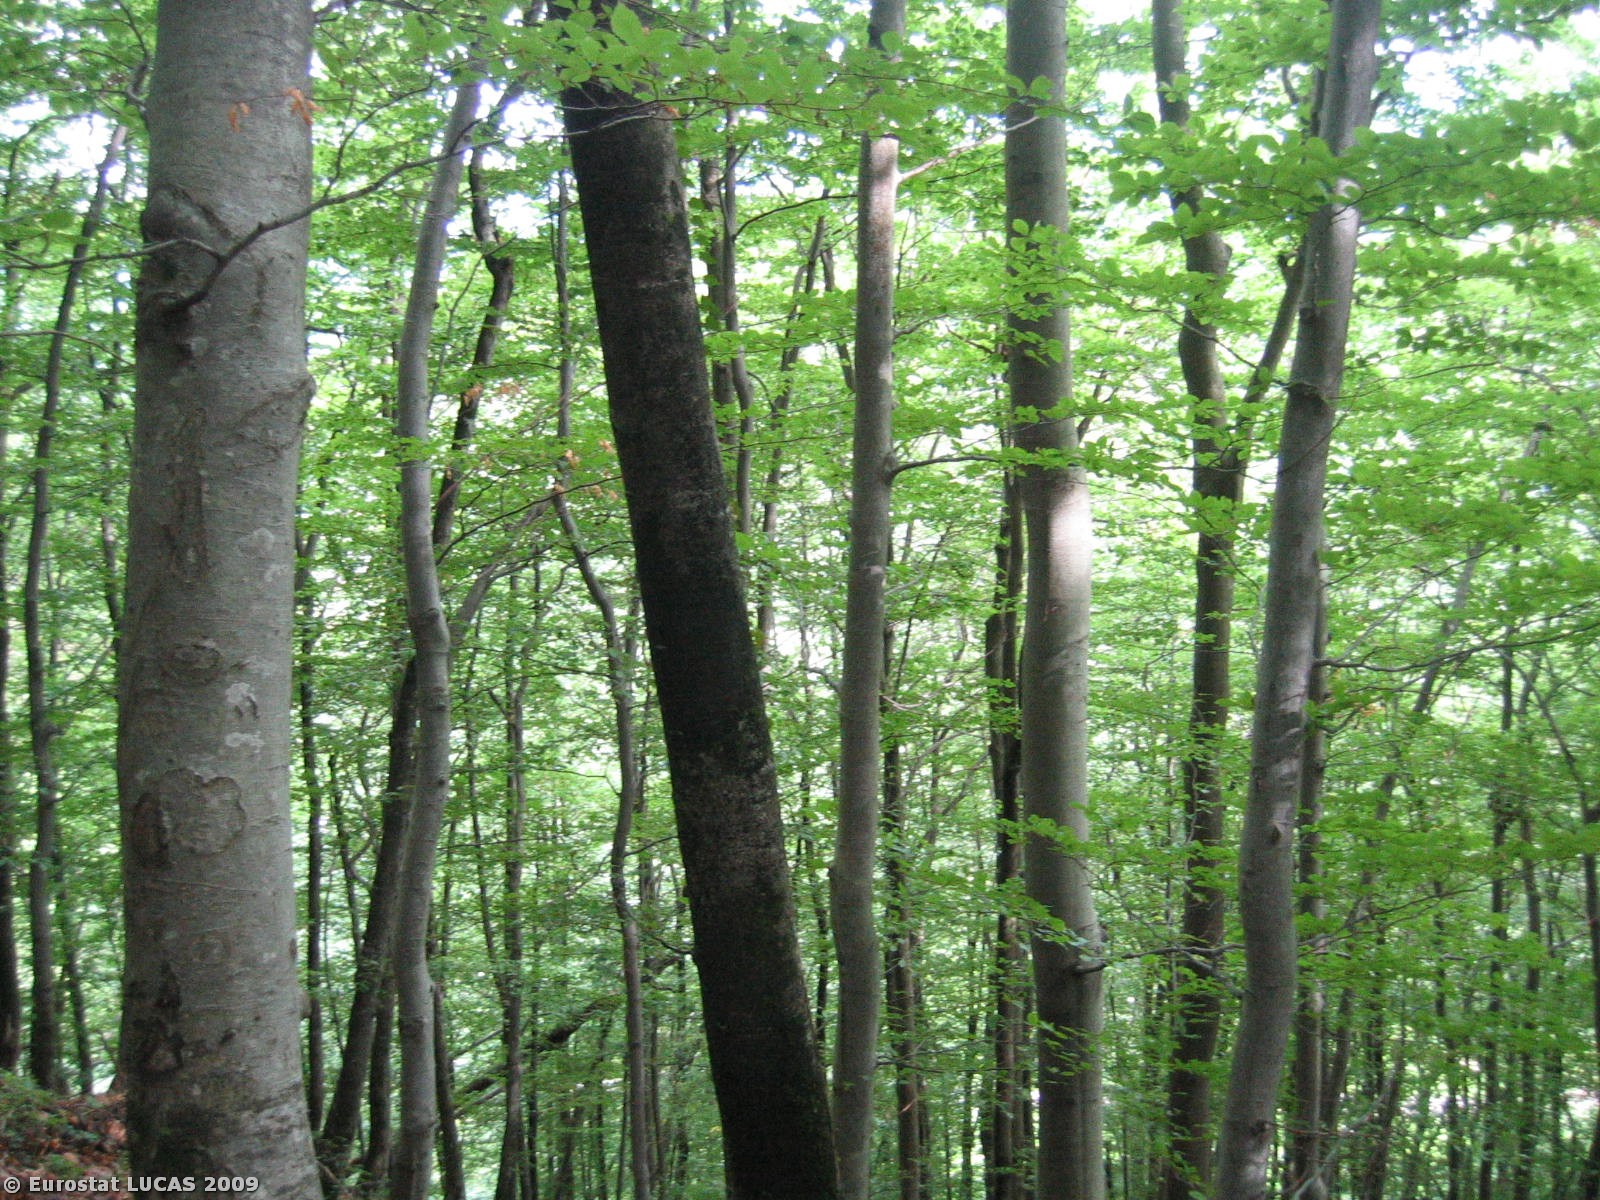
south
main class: Woodland
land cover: Broadleaved woodland
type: mountainous beech forest
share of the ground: > 75 %
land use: Forestry
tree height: > 5 m
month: June
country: SI
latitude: 46.2312
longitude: 14.2368
